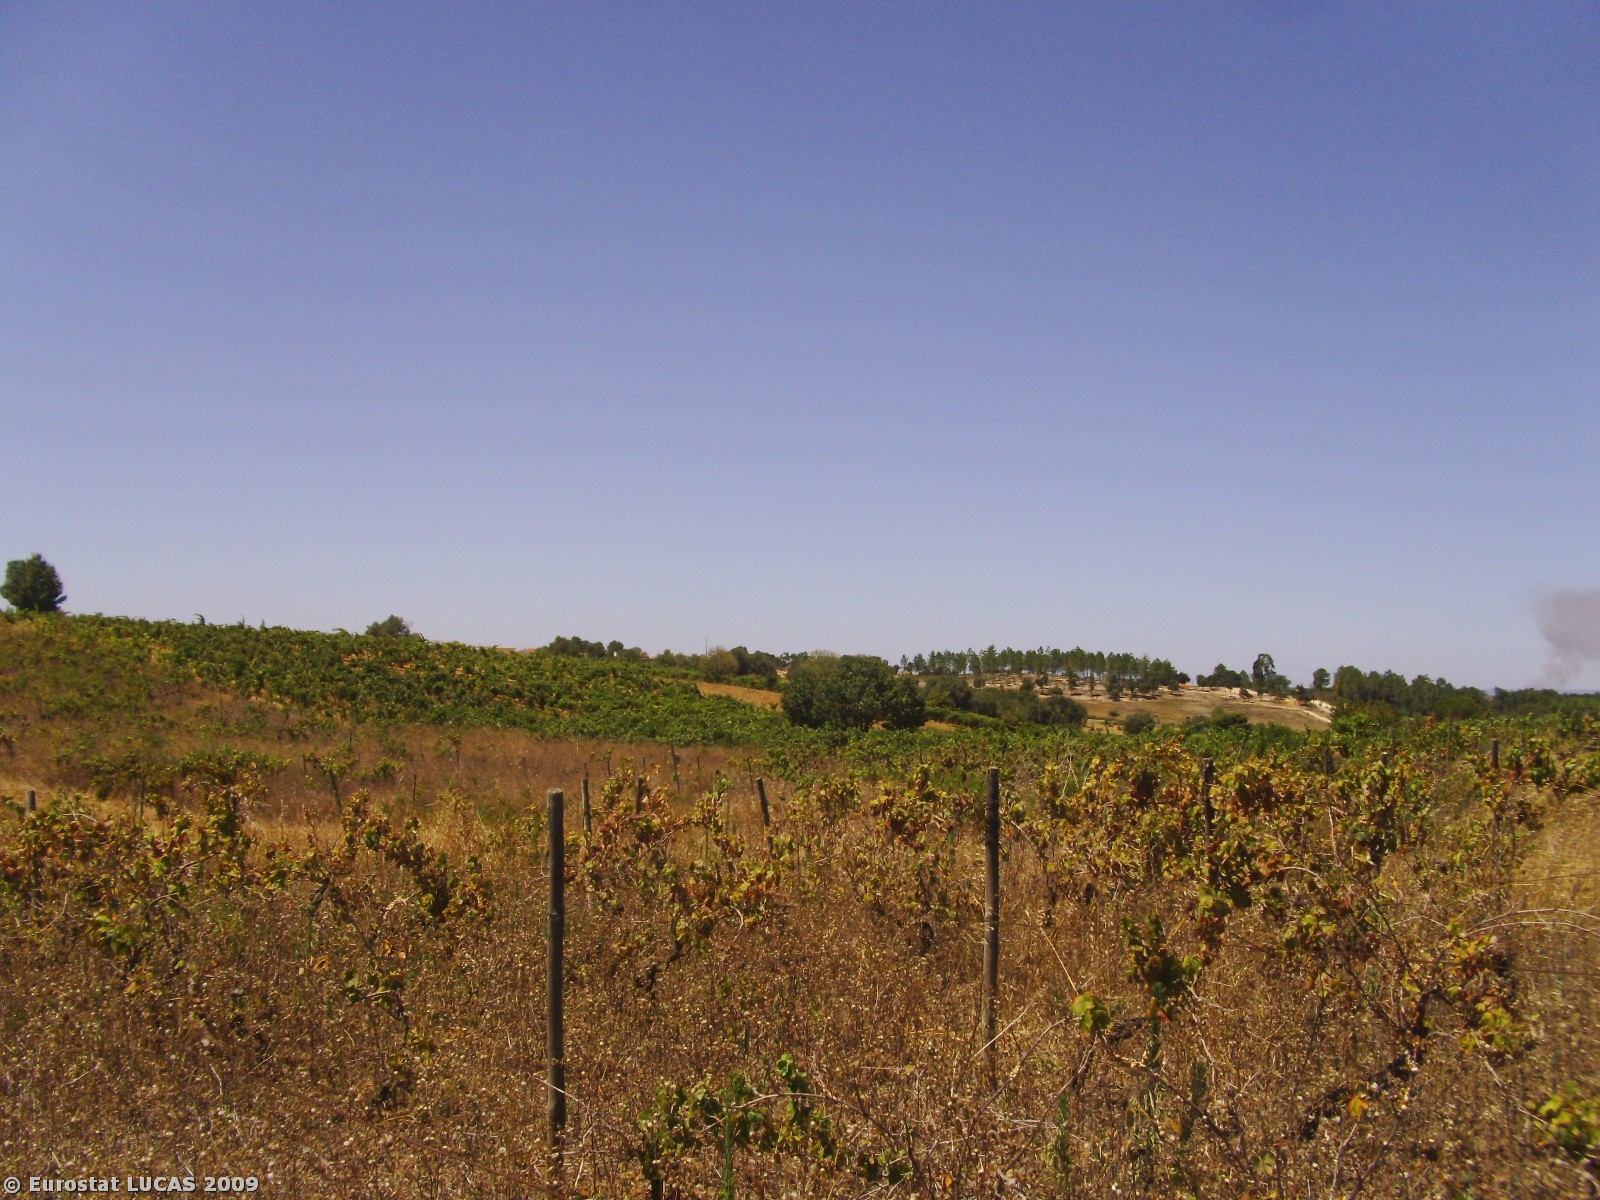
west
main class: Cropland
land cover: Vineyards
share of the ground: 25 - 50 %
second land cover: Spontaneously vegetated surfaces
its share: 25 - 50 %
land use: Fallow land
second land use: Unused
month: July
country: PT
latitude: 39.1254
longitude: -8.8485
